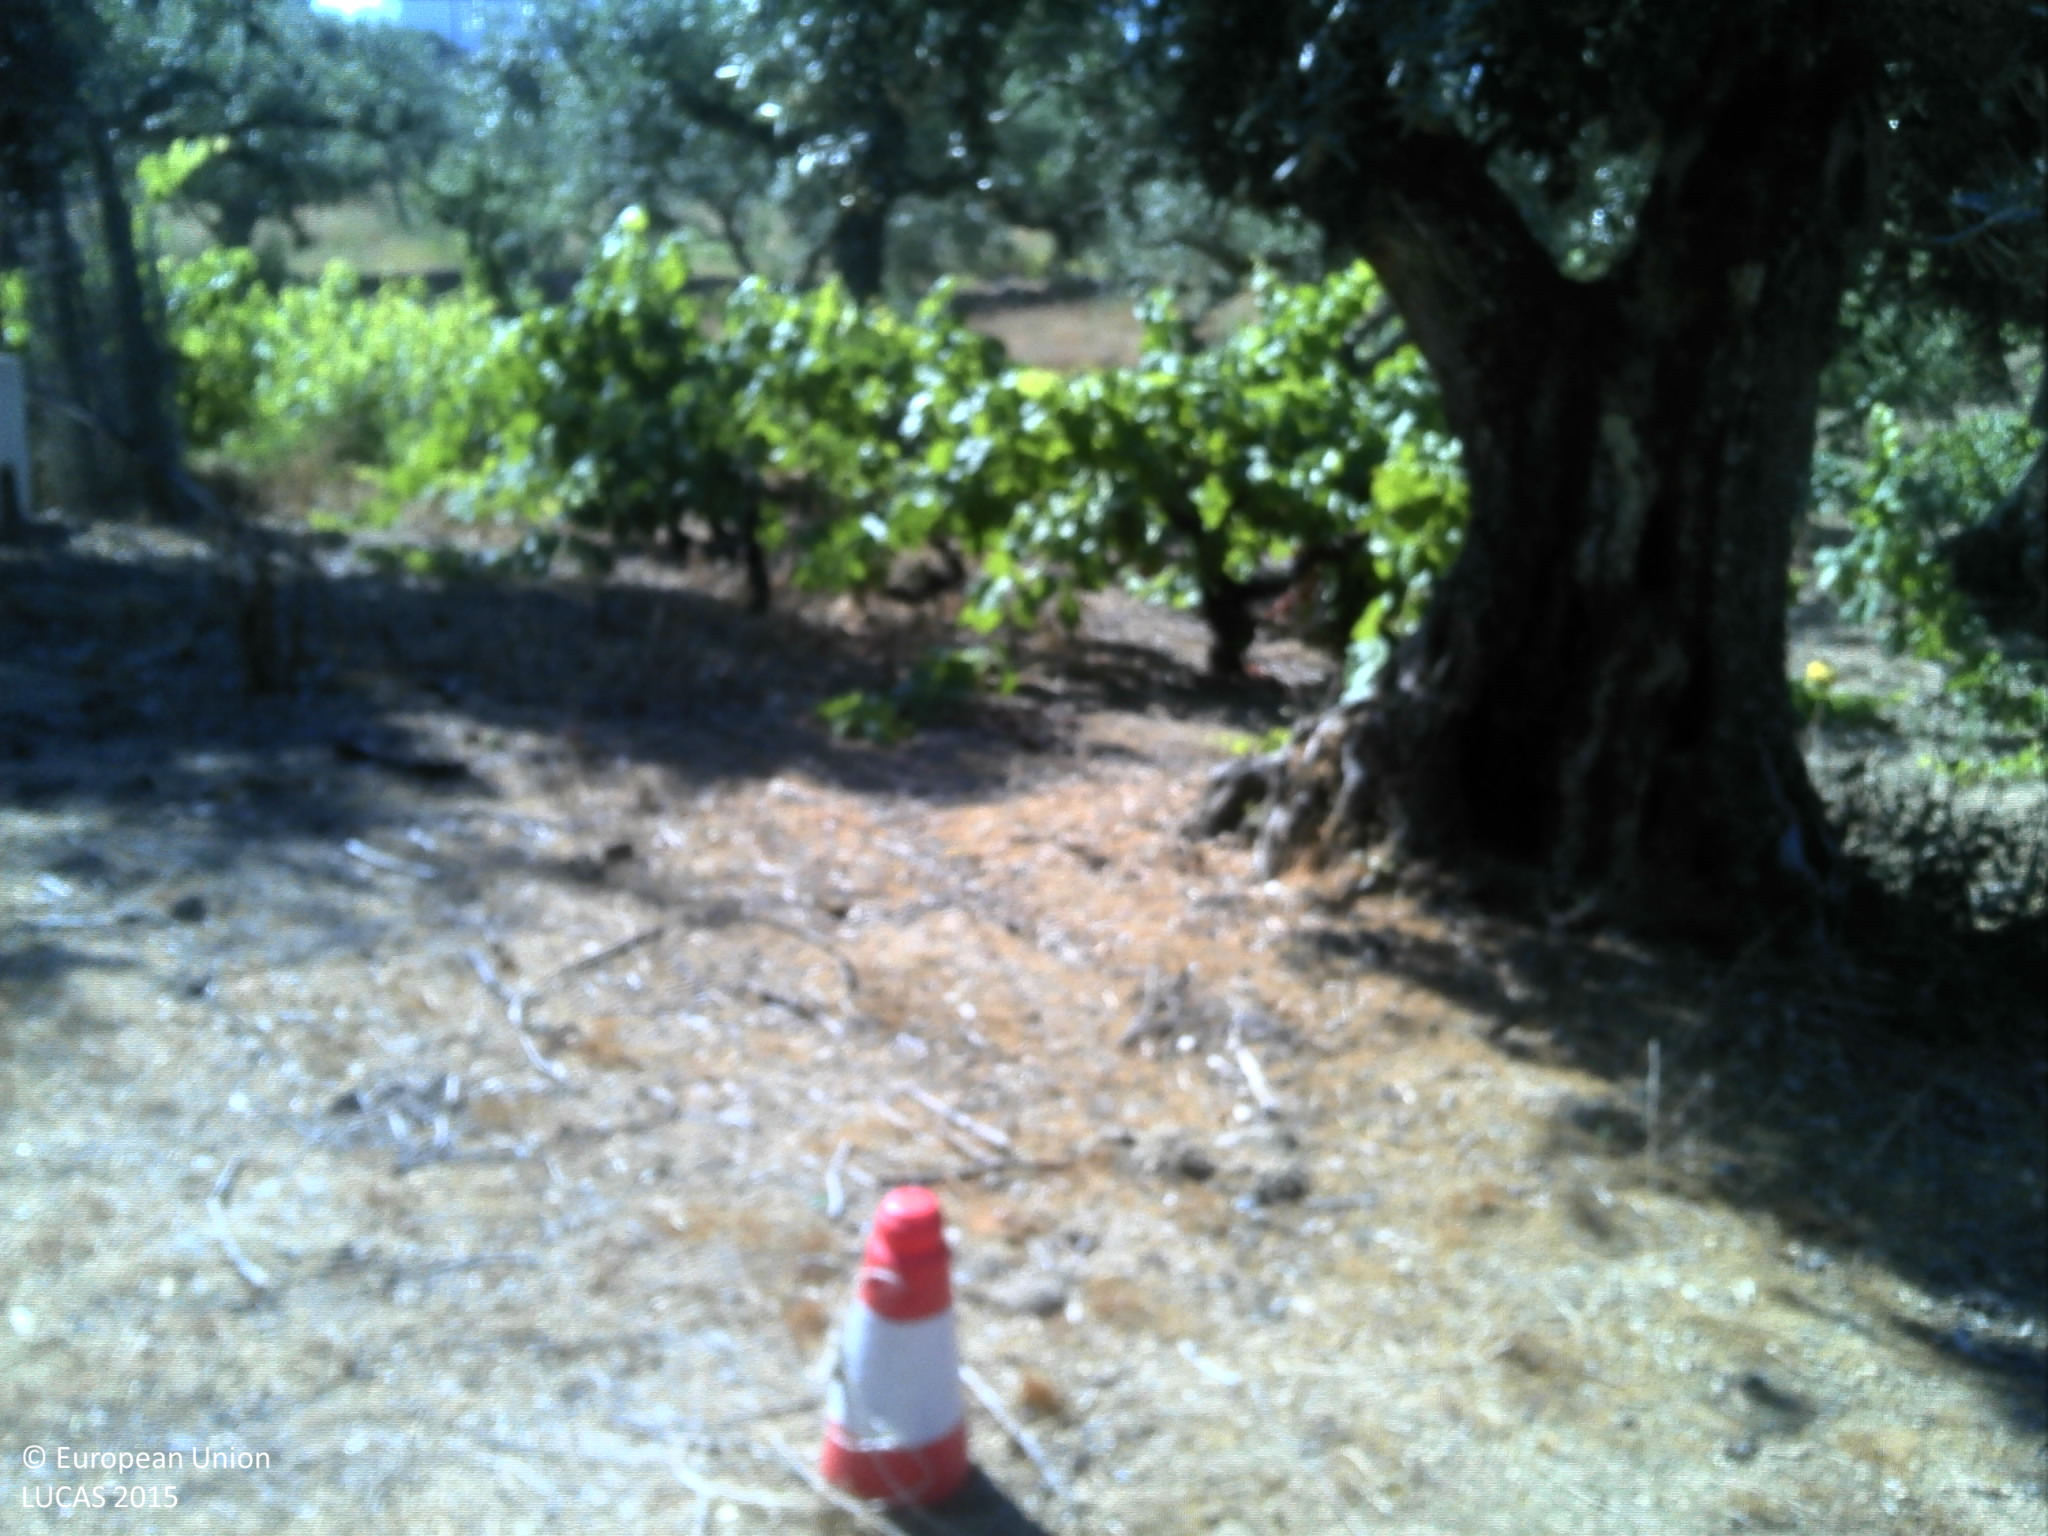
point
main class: Cropland
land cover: Olive groves
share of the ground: 25 - 50 %
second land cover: Vineyards
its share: 10 - 25 %
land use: Agriculture (excluding fallow land and kitchen gardens)
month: June
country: PT
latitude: 39.8527
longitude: -7.5515
